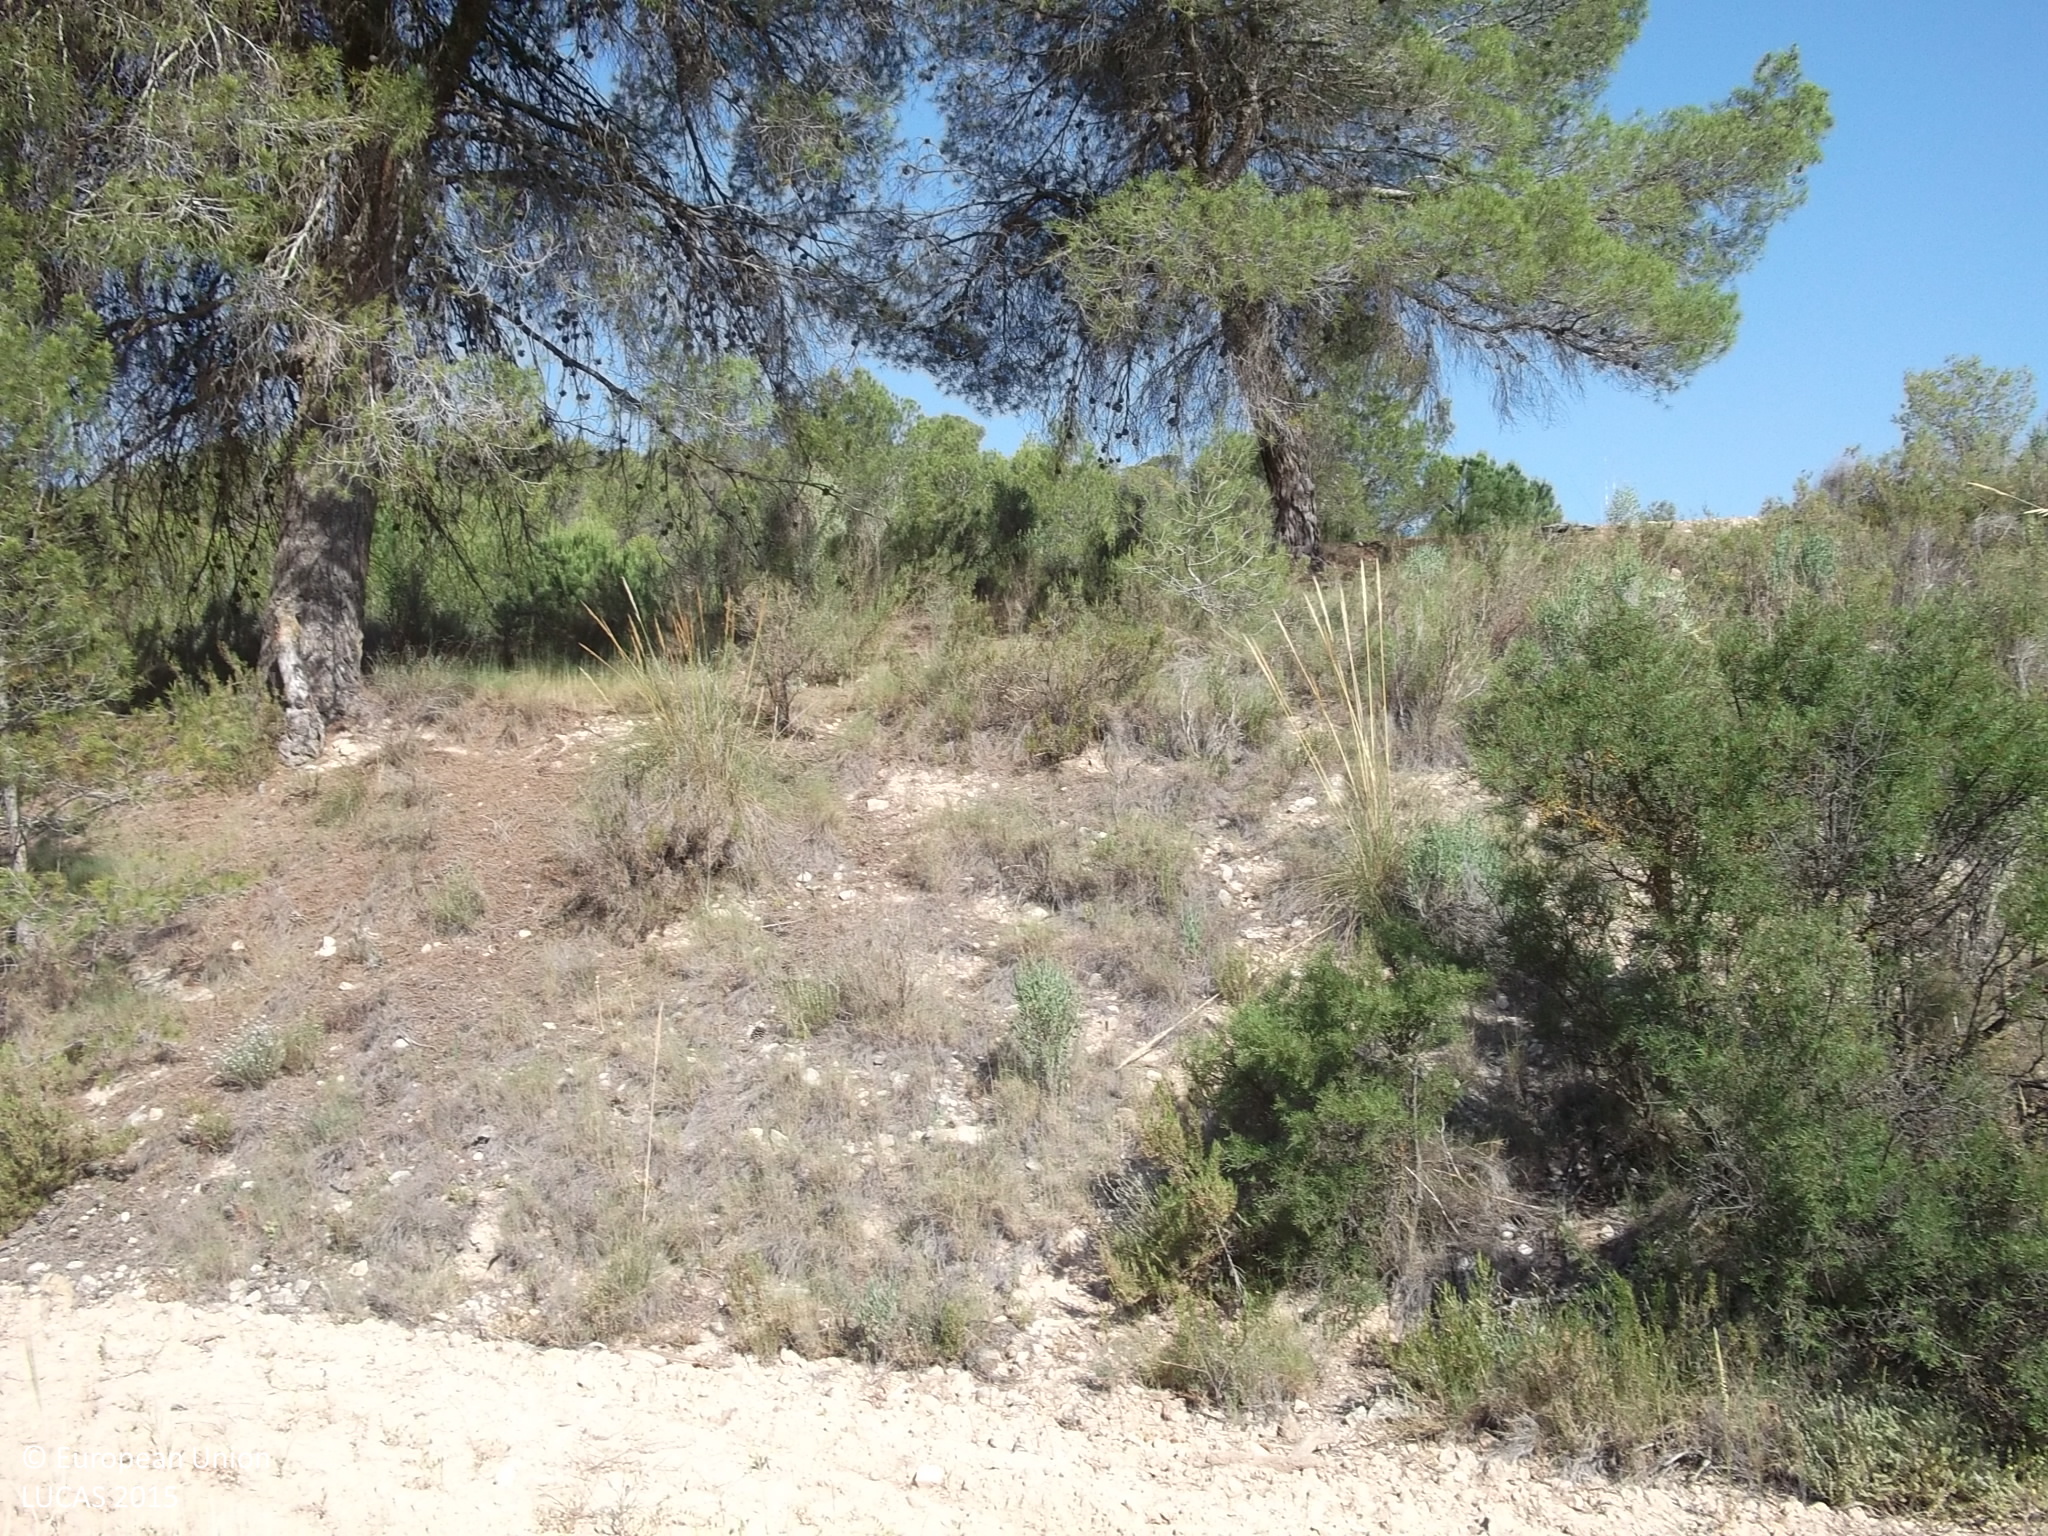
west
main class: Cropland
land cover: Barley
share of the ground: > 75 %
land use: Agriculture (excluding fallow land and kitchen gardens)
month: June
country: ES
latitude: 38.1135
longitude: -1.6101
